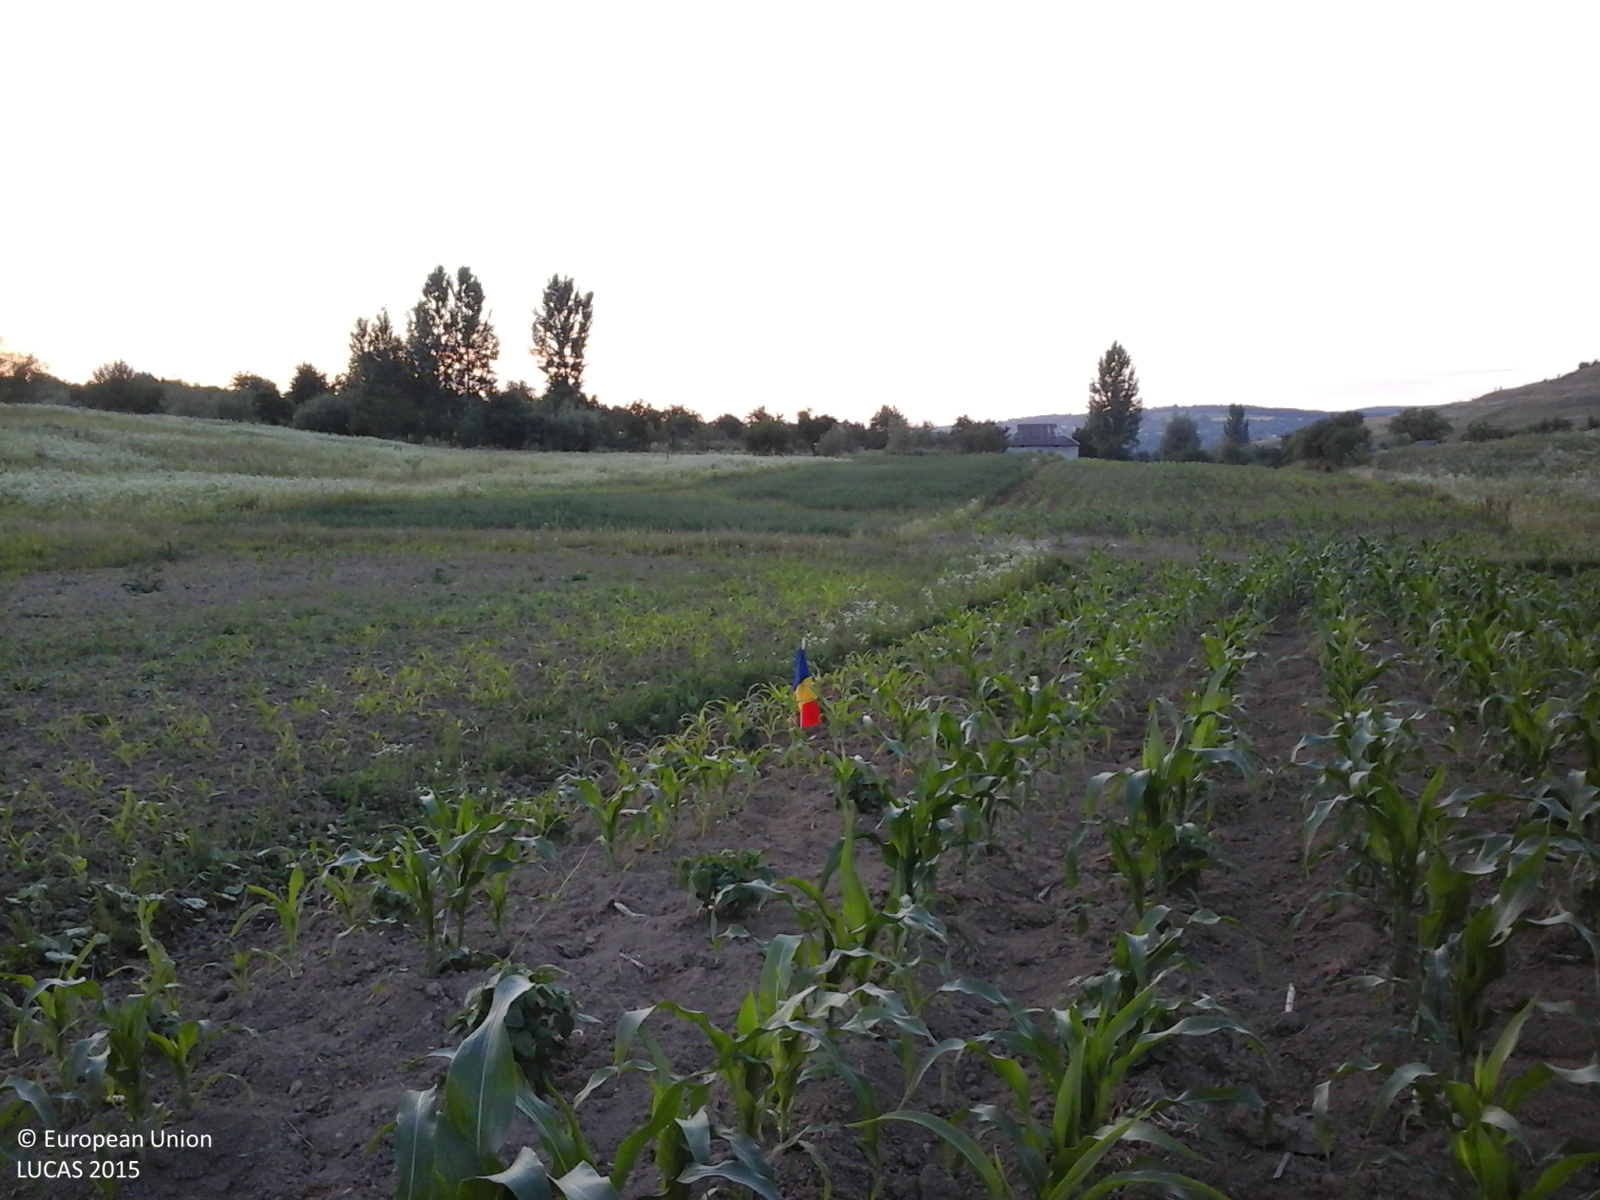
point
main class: Cropland
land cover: Maize
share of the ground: 25 - 50 %
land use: Agriculture (excluding fallow land and kitchen gardens)
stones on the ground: < 10 %
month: June
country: RO
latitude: 47.6033
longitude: 26.7908
